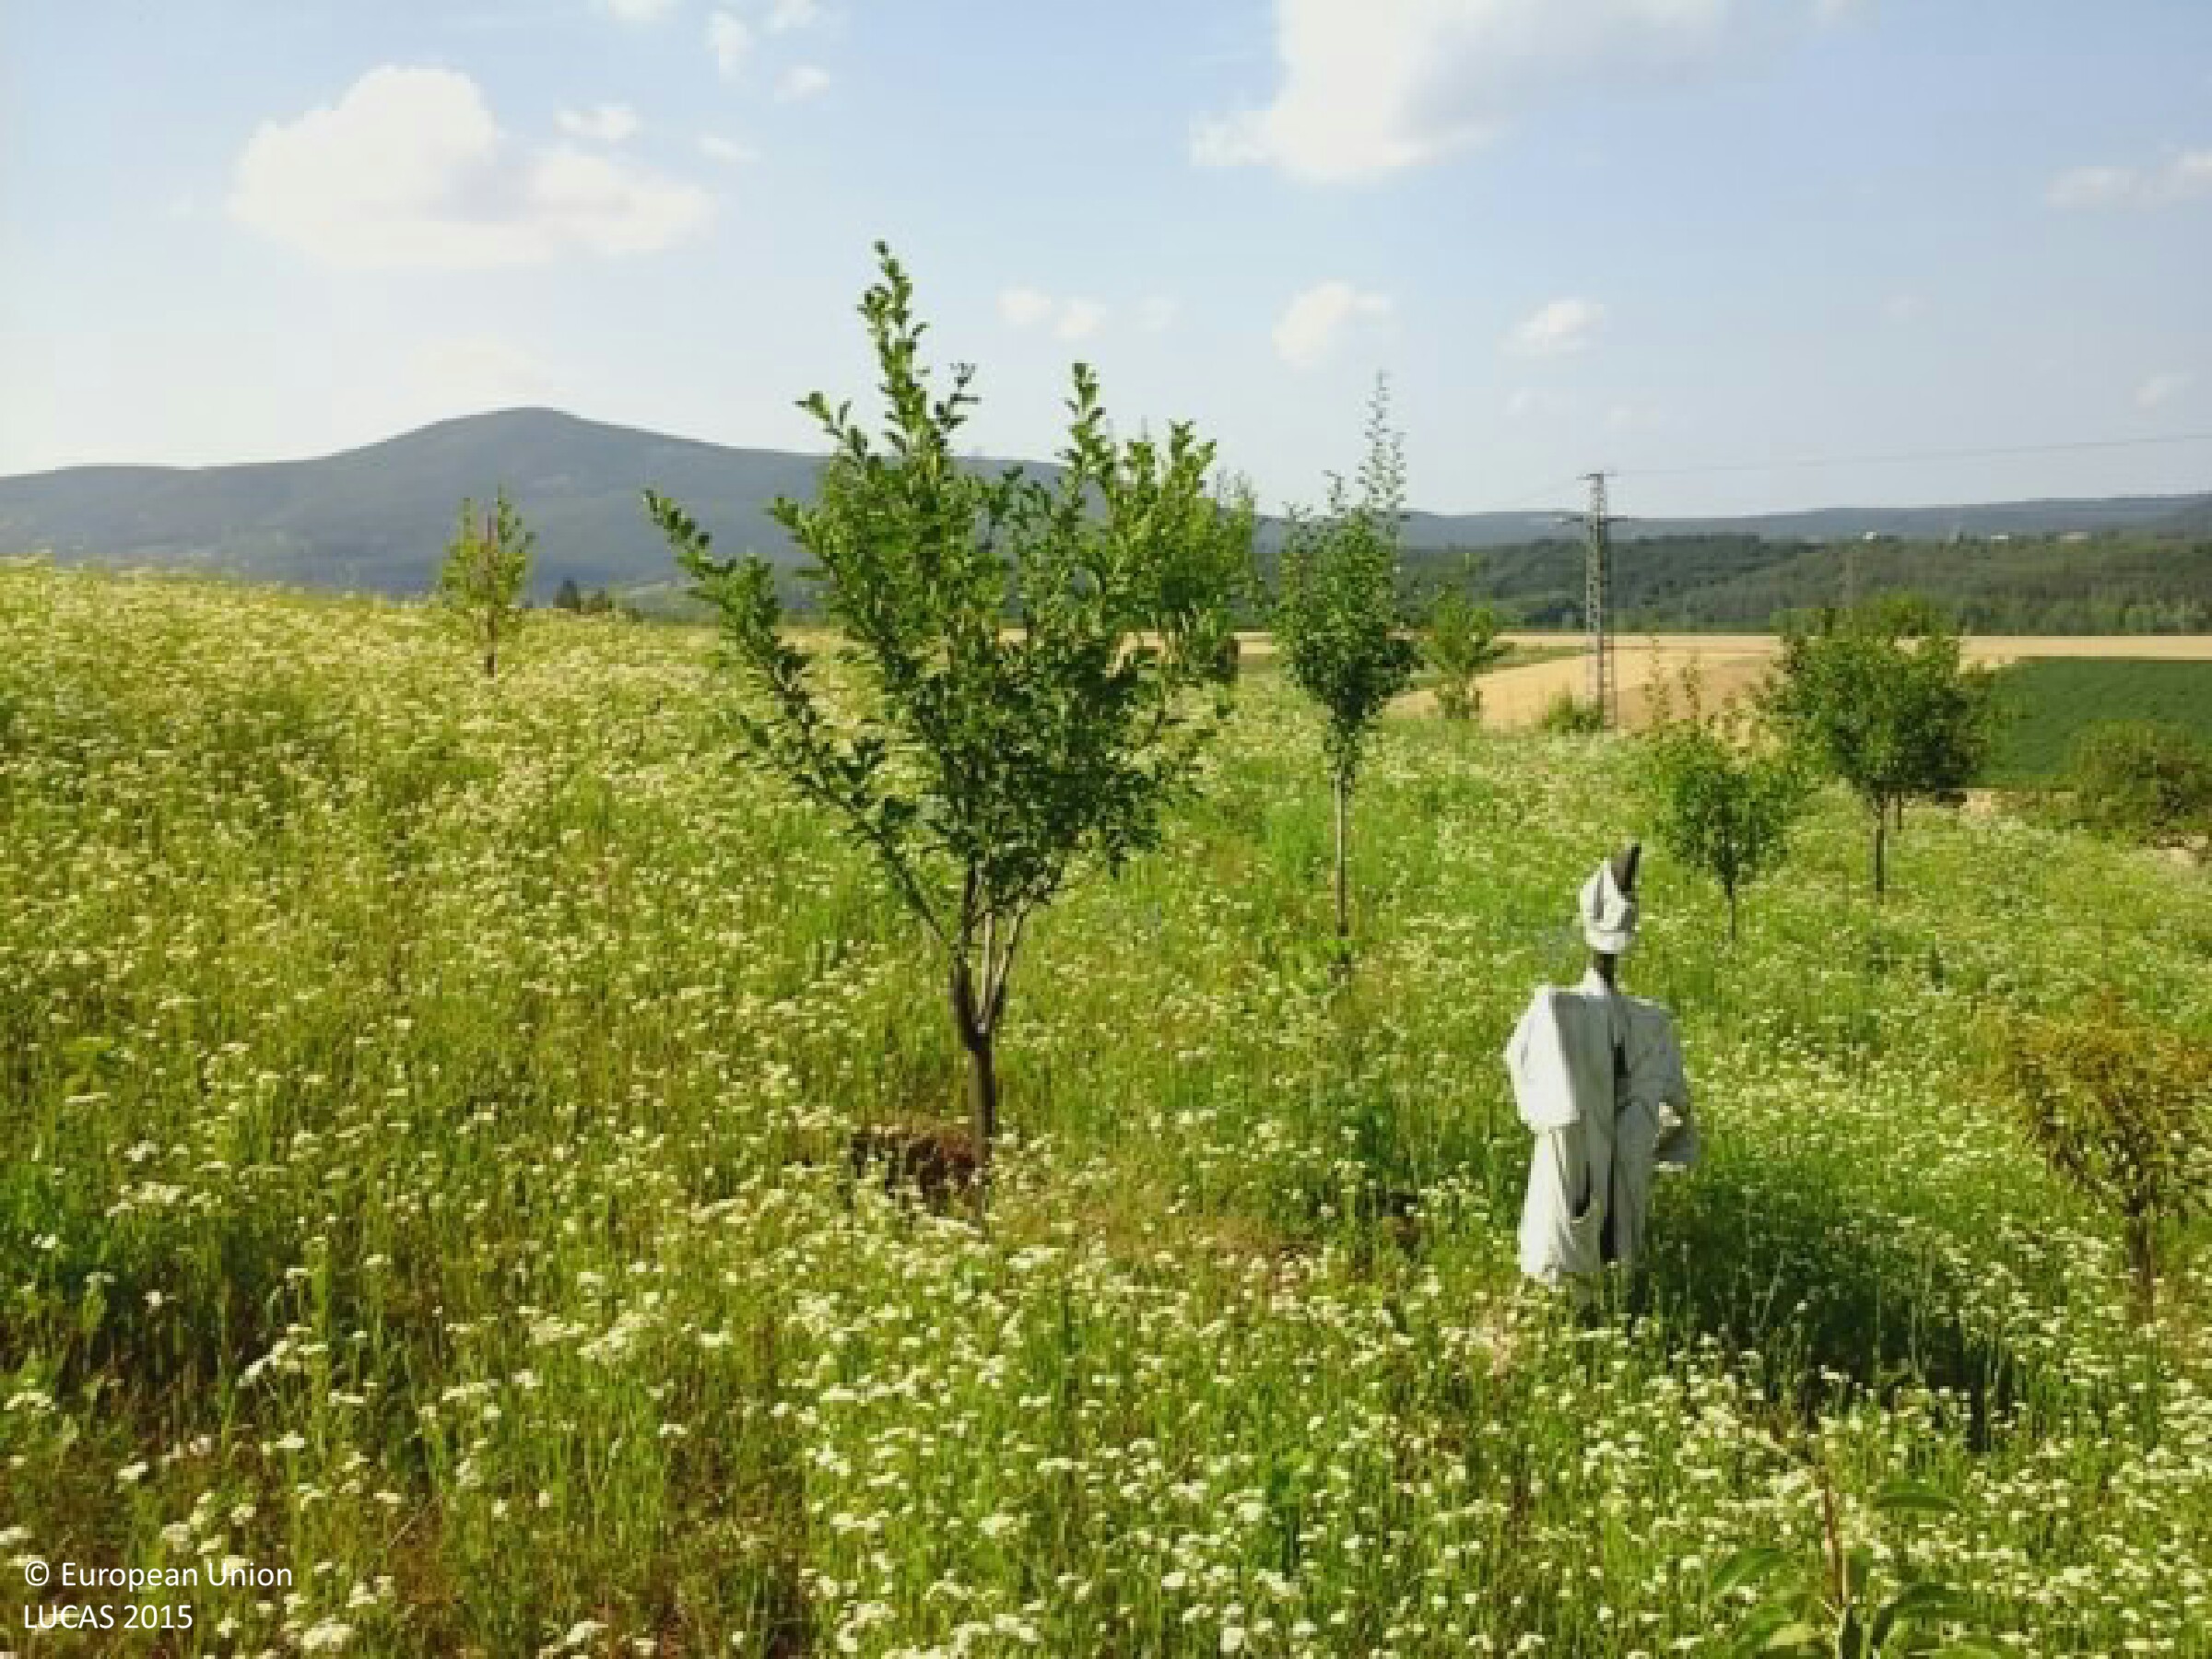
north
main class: Grassland
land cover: Grassland with sparse tree/shrub cover
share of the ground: > 75 %
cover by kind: herbaceous plants 95 %, broadleaved forest trees 5 %
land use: Agriculture (excluding fallow land and kitchen gardens)
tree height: < 5 m
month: July
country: HU
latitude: 47.7869
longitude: 19.1630
